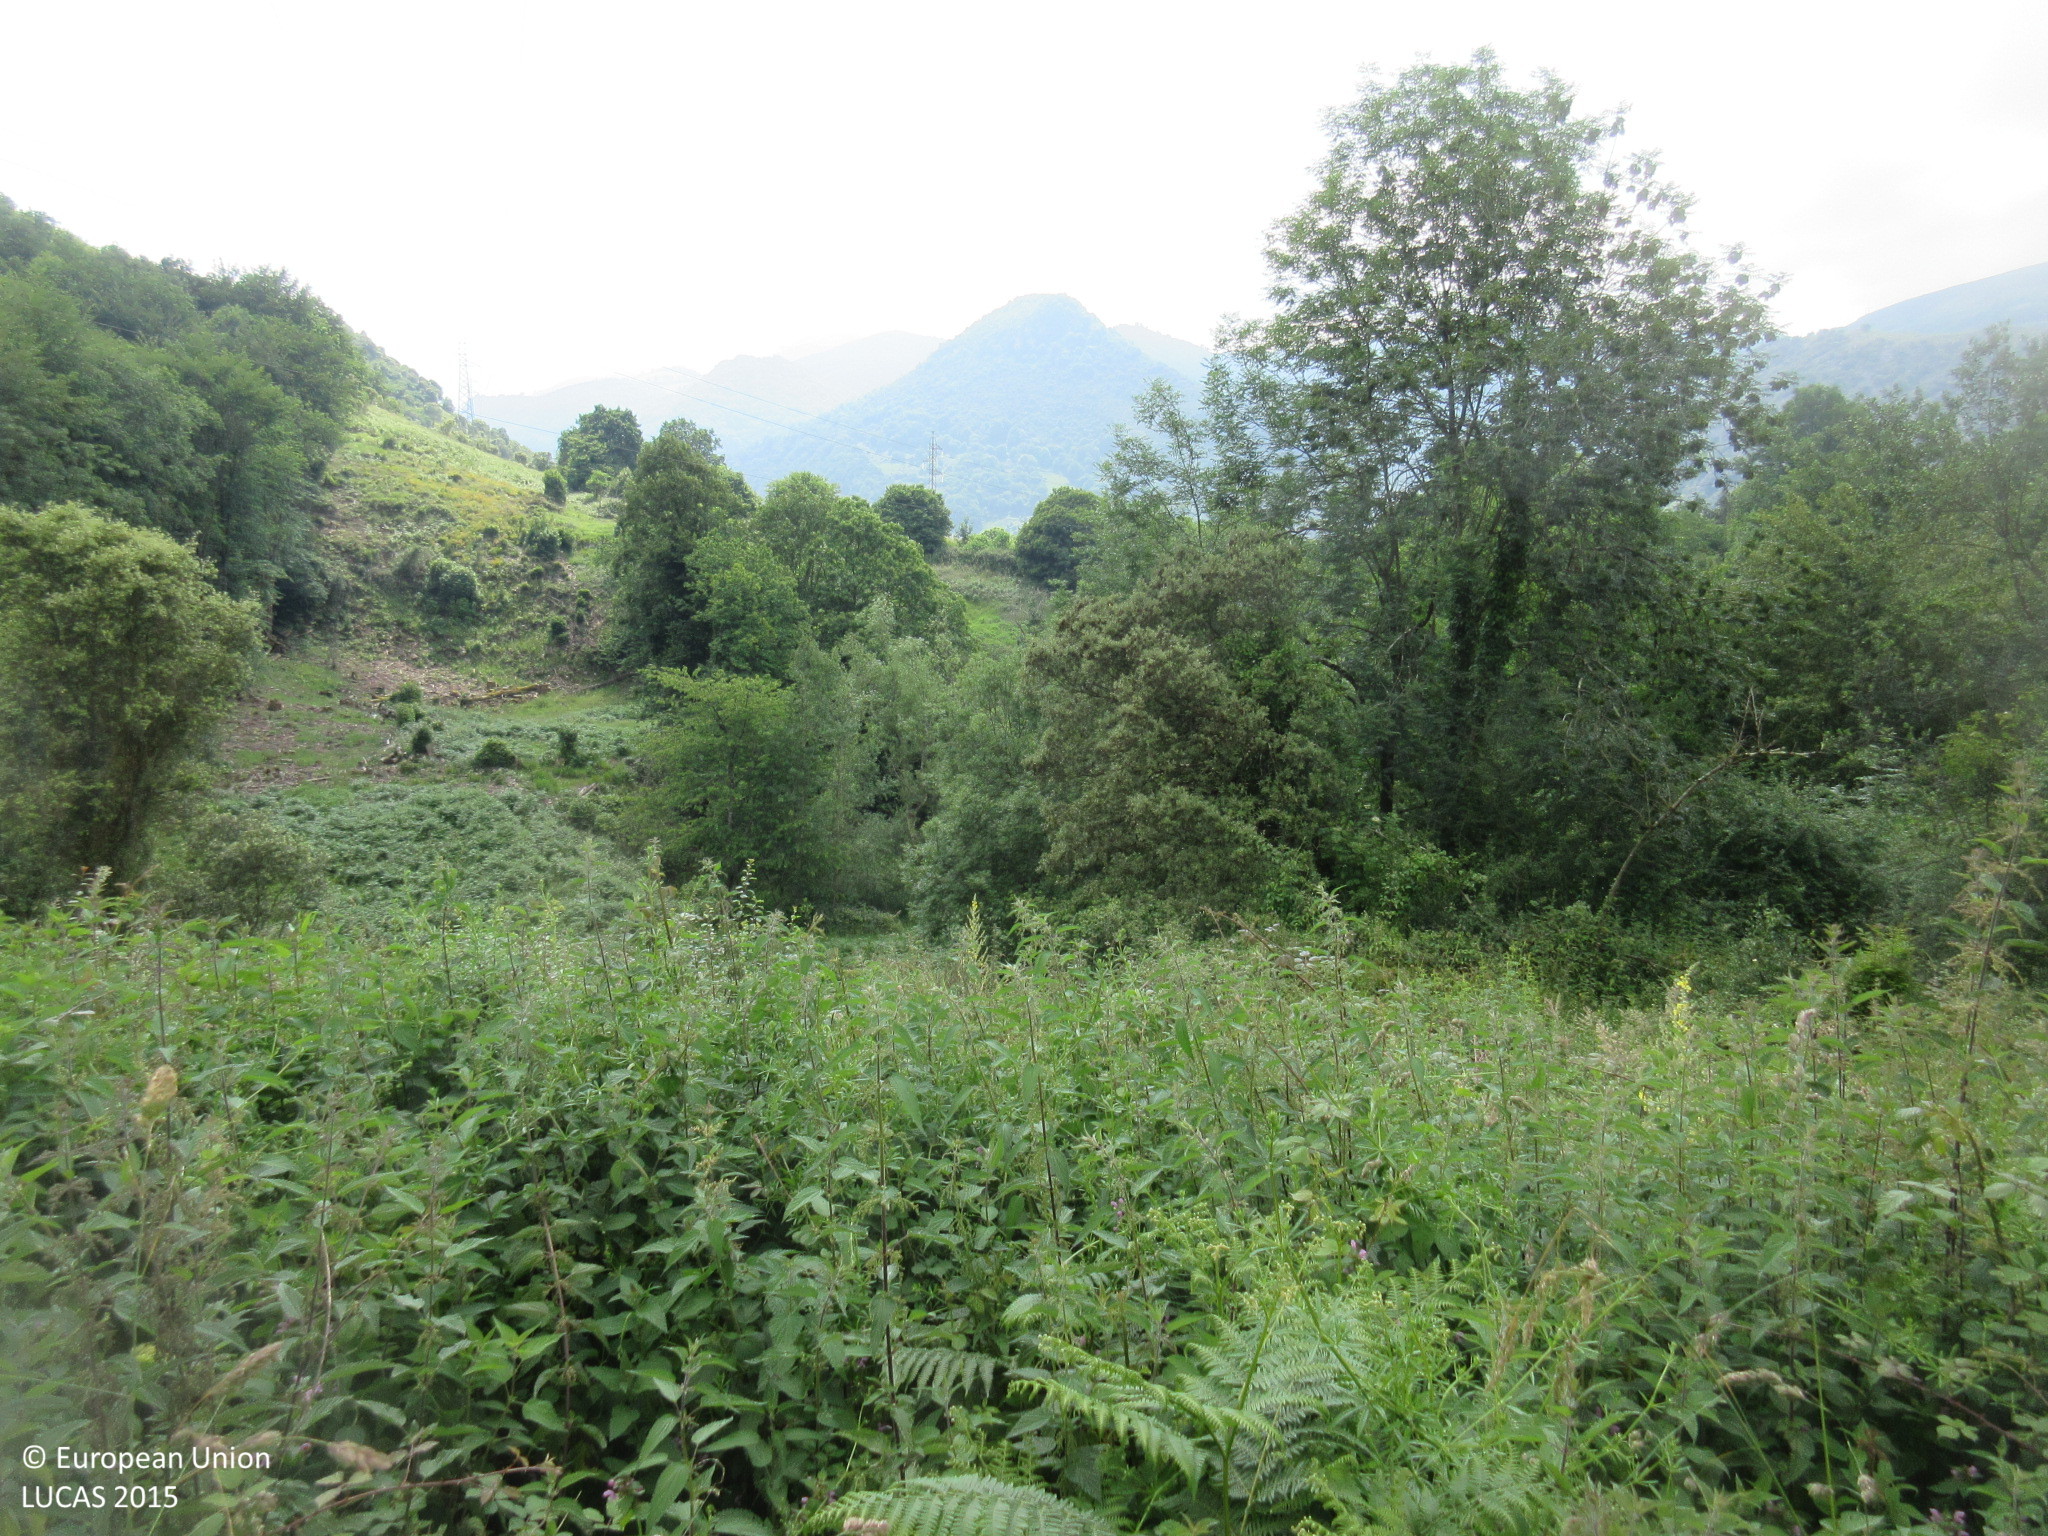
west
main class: Shrubland
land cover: Shrubland without tree cover
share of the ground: > 75 %
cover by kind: shrubs 90 %, herbaceous plants 10 %
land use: Agriculture (excluding fallow land and kitchen gardens)
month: June
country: ES
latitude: 43.2868
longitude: -5.9756
